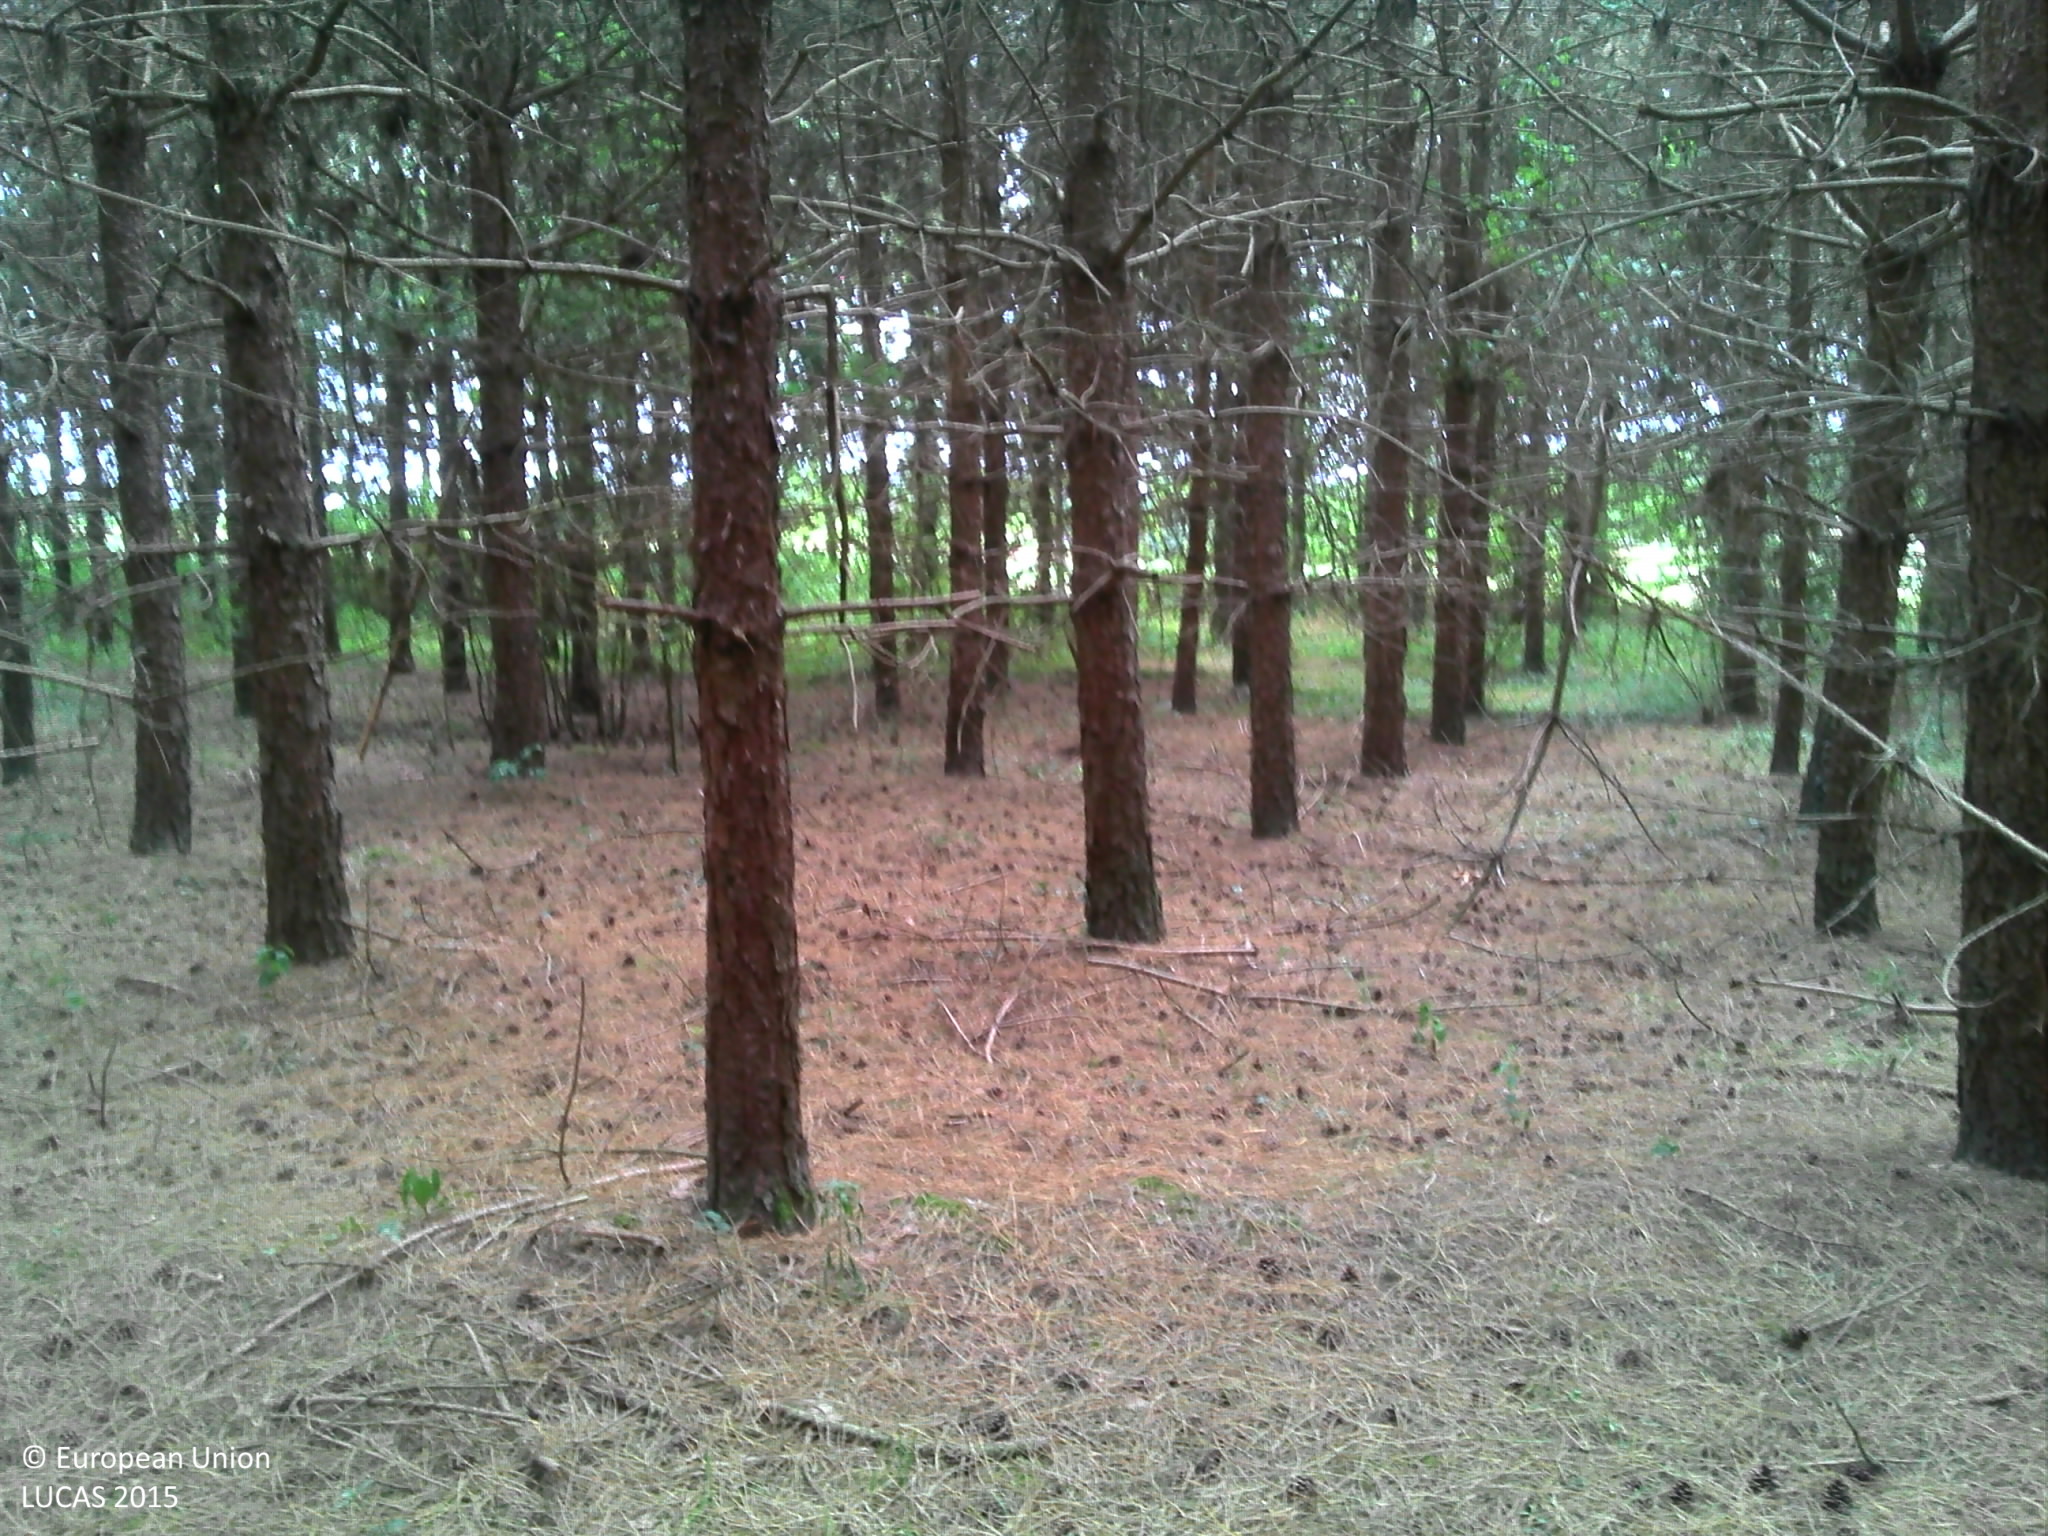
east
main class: Woodland
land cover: Pine dominated coniferous woodland
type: exotic forest
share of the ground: > 75 %
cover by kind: coniferous forest trees 90 %, shrubs 5 %, lichens and mosses 5 %
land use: Forestry
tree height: > 5 m
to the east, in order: Pine dominated coniferous woodland; Grass margins; Ditches and canals; Grass margins; Tracks; Grass margins; Common wheat; Grass margins; Paved roads, cycling and walking lanes; Grass margins; Ditches and canals; Grass margins; Rape and turnip rape
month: July
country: FR
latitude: 46.9946
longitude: 0.4730
